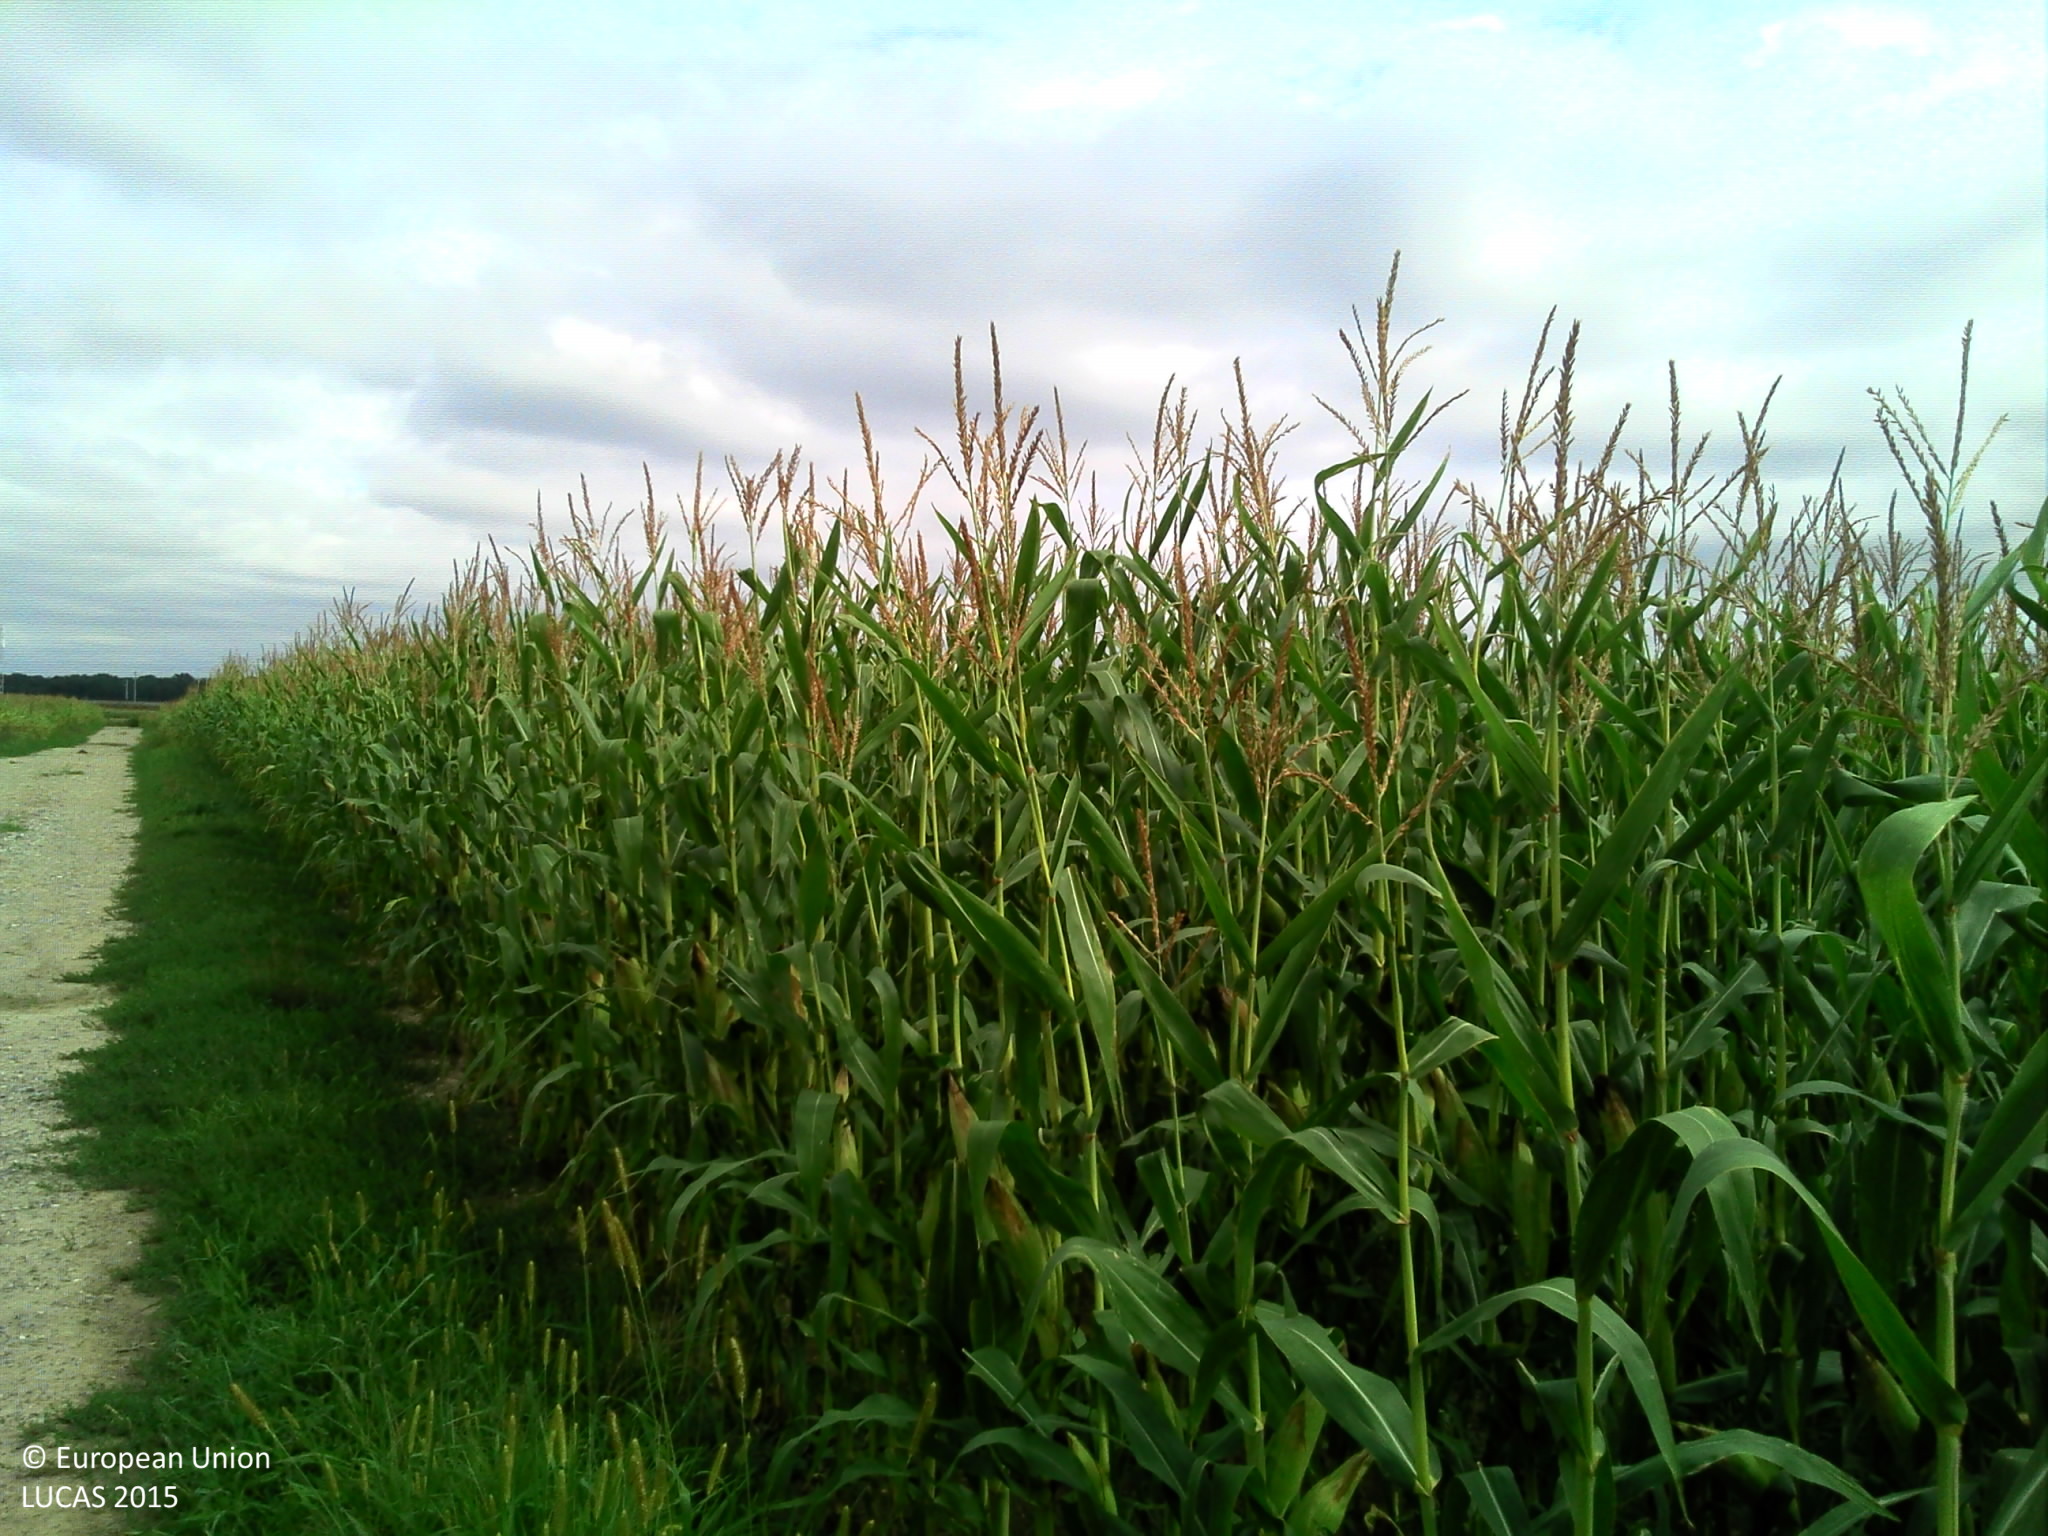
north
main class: Cropland
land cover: Maize
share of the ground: > 75 %
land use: Agriculture (excluding fallow land and kitchen gardens)
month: August
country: FR
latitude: 48.6857
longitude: 7.7052
